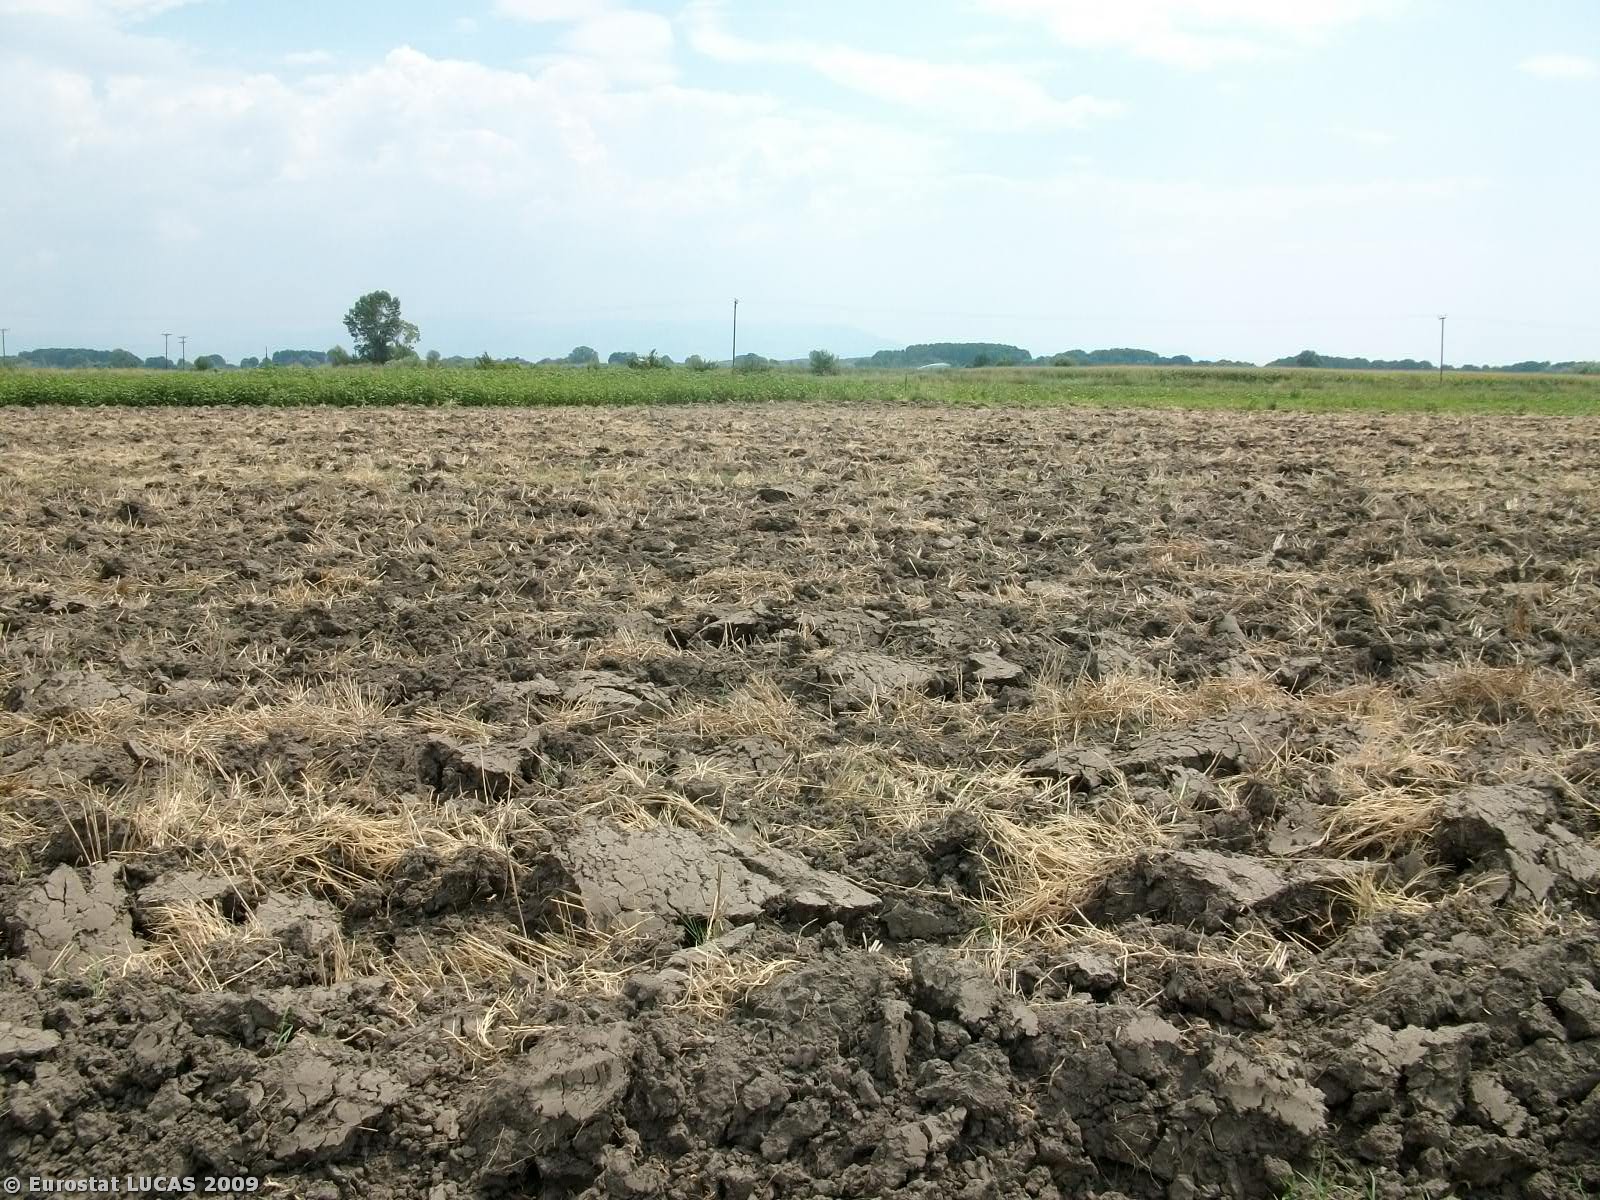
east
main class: Cropland
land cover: Durum wheat
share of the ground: < 10 %
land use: Agriculture (excluding fallow land and kitchen gardens)
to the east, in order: Durum wheat; Bare land; Cotton; Grass margins; Fences; Other fruit trees and berries; Fences; Grass margins; Paved roads, cycling and walking lanes; Grass margins; Electric lines; Cotton
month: August
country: GR
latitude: 41.0606
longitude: 24.0805
